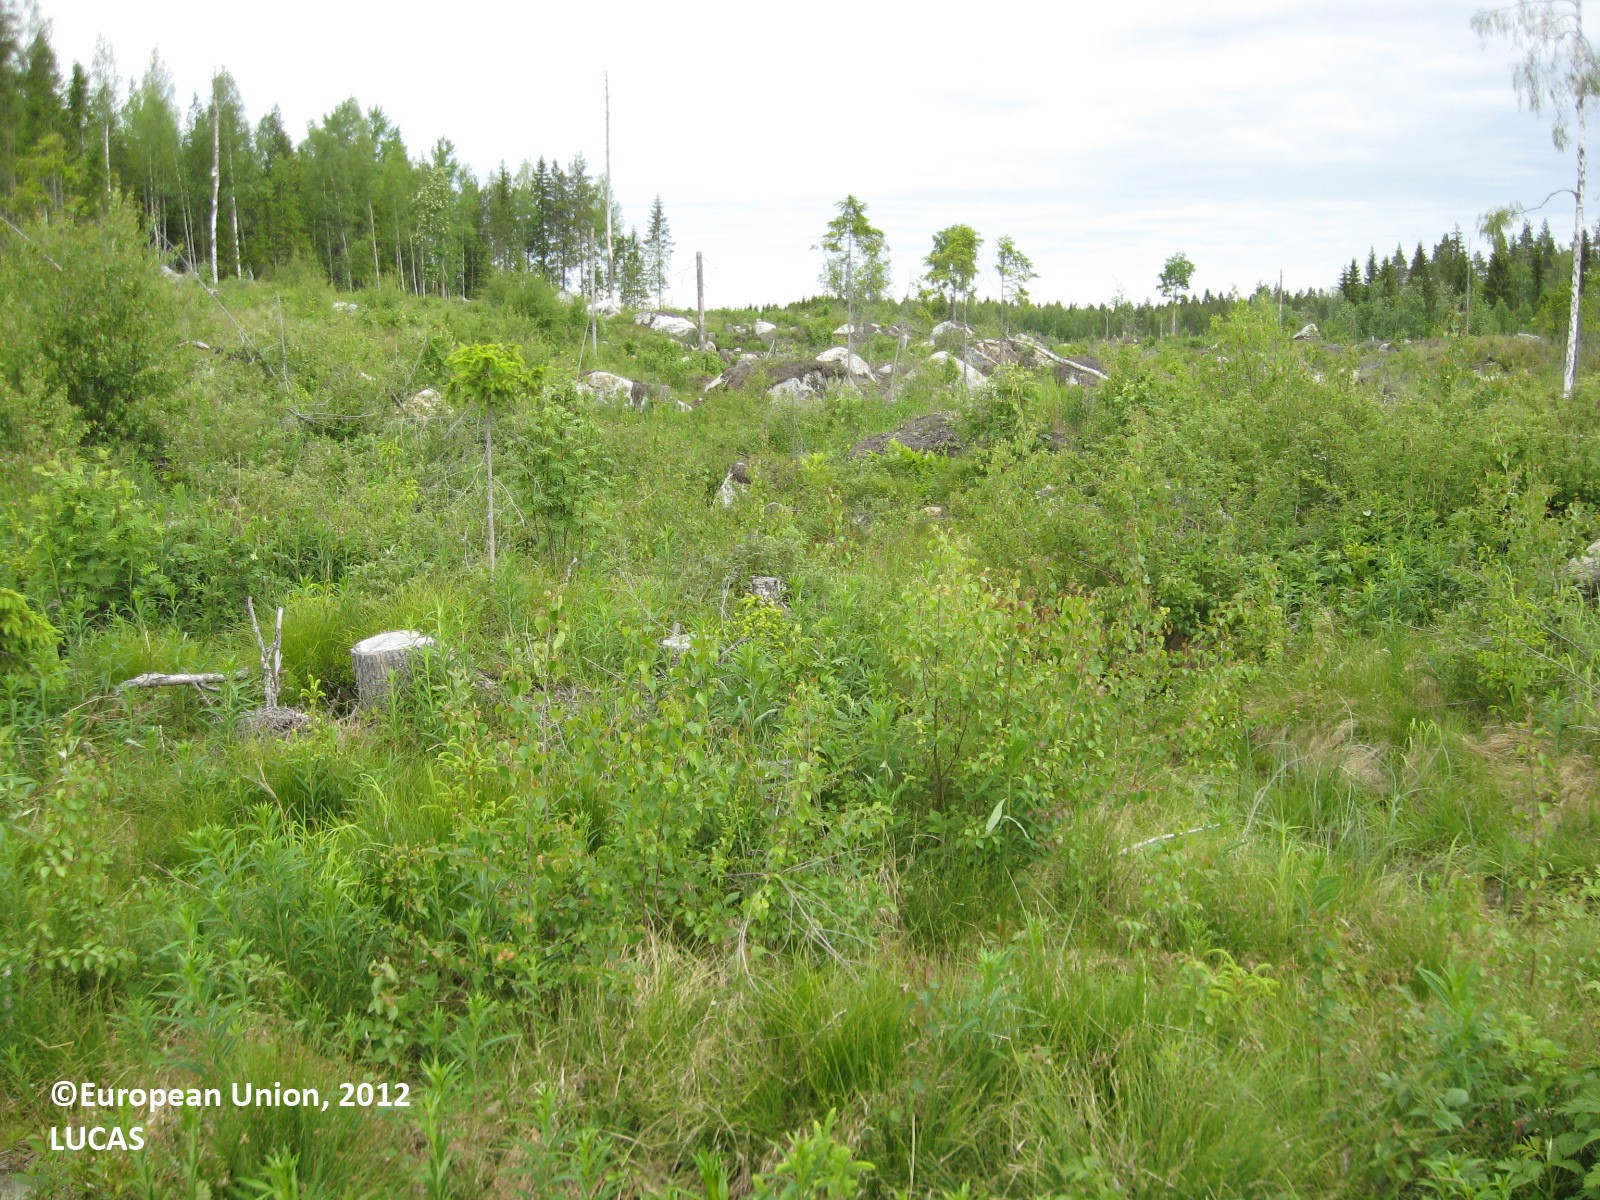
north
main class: Grassland
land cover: Grassland with sparse tree/shrub cover
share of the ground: > 75 %
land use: Forestry
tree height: < 5 m
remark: Clear cut
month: June
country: FI
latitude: 63.1033
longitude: 21.9518
